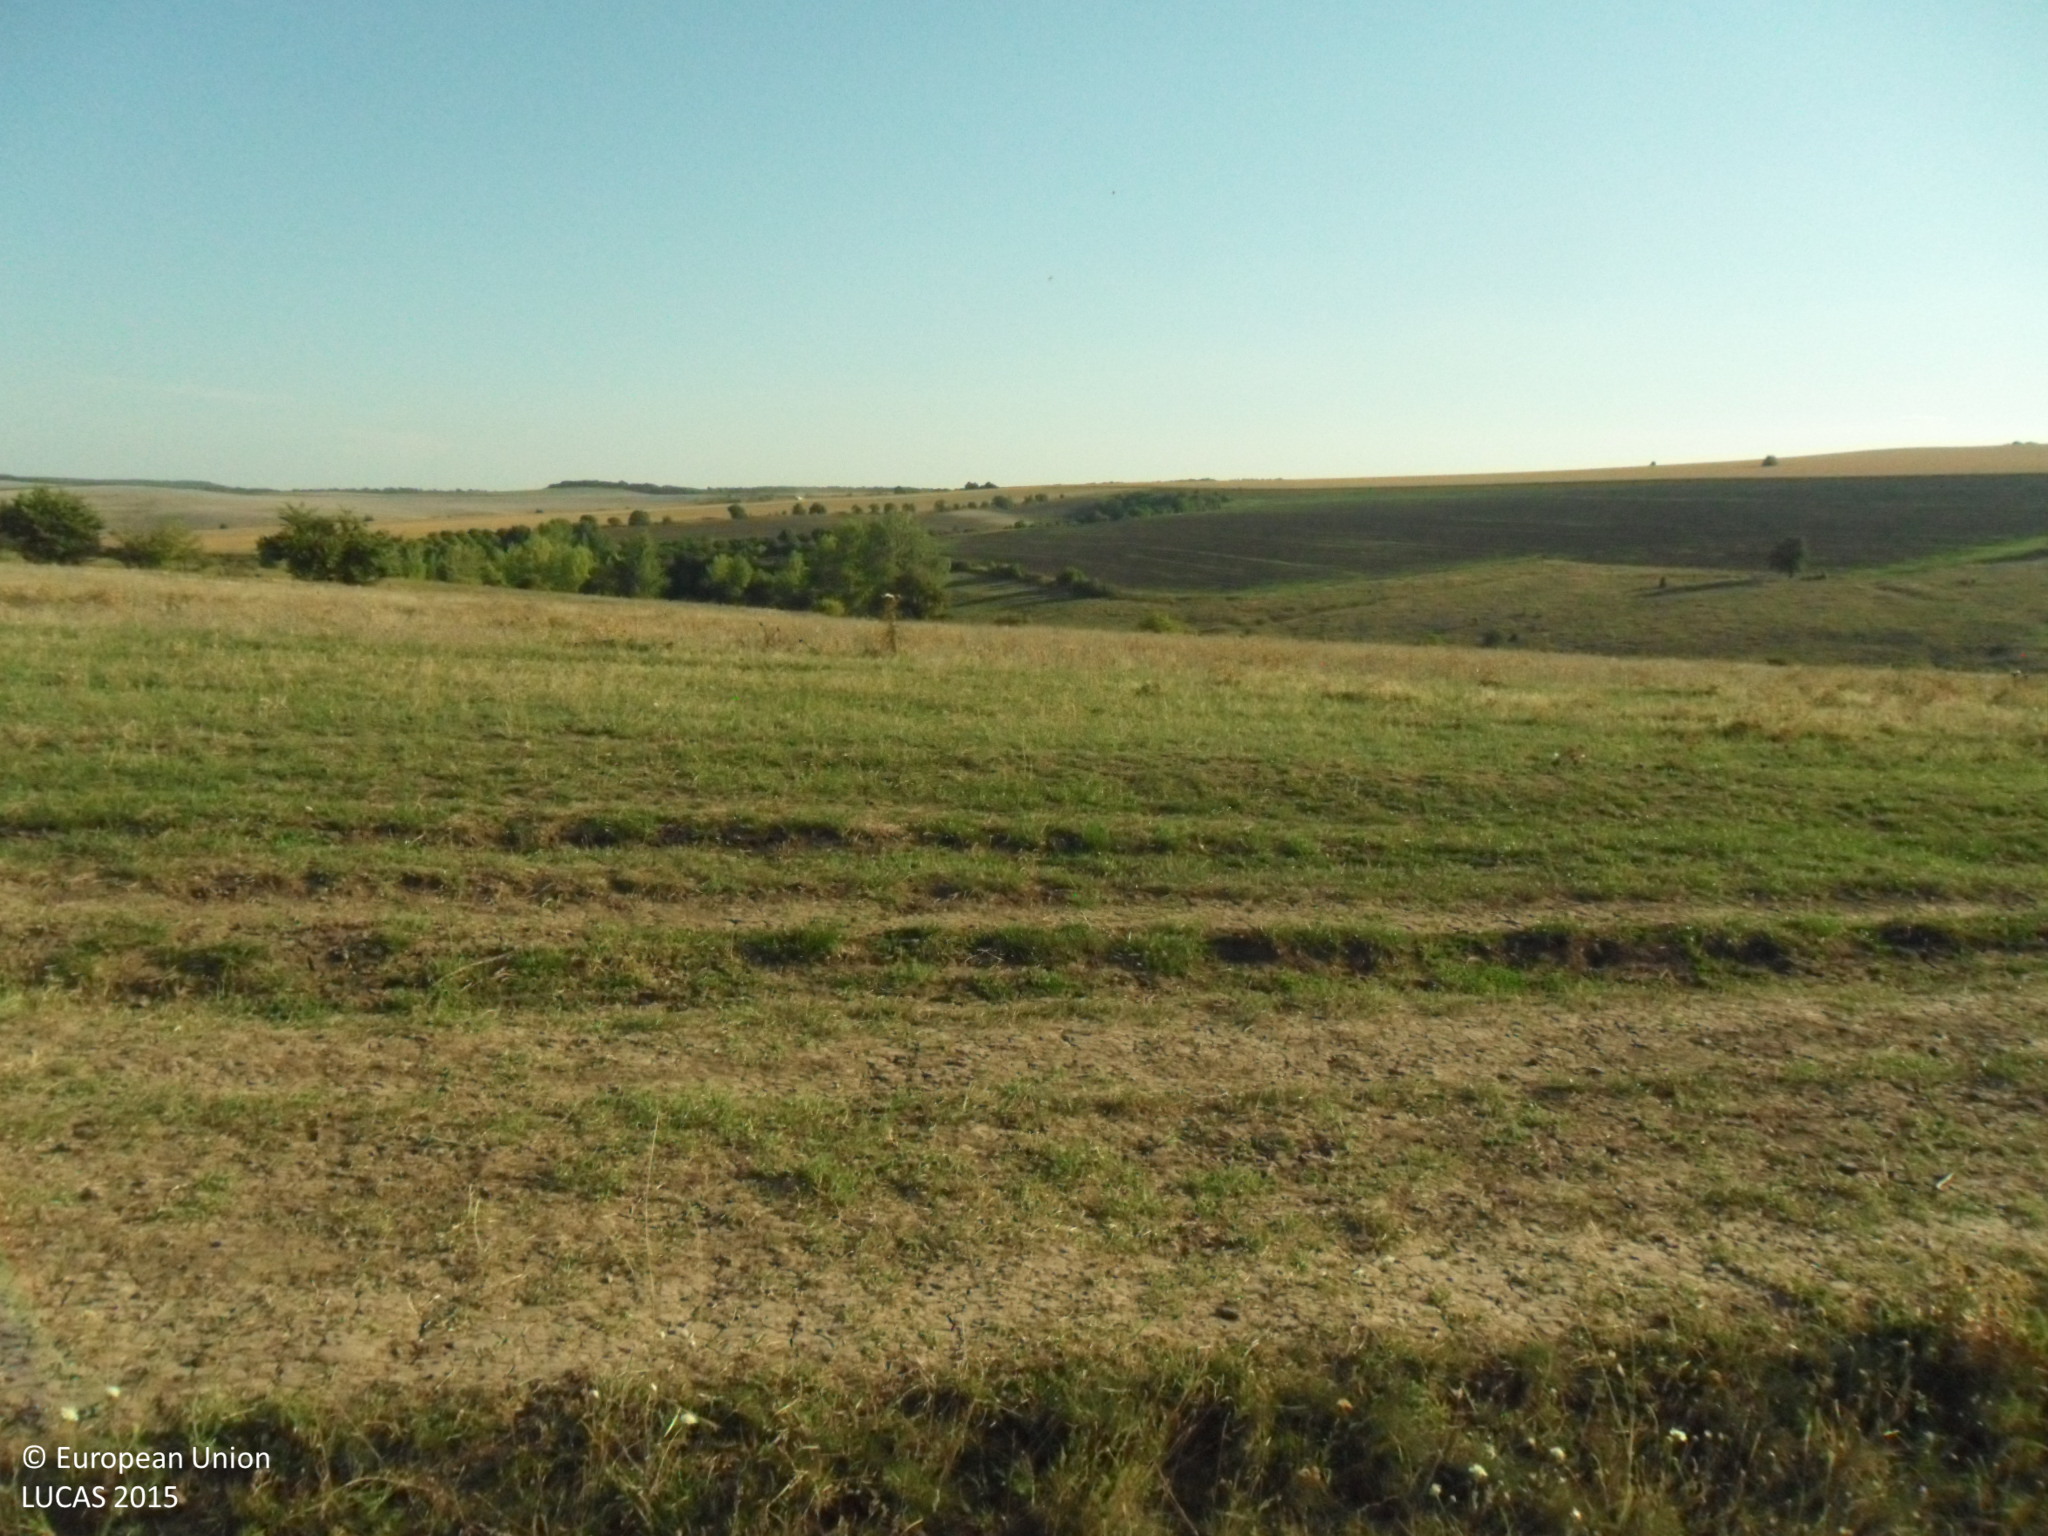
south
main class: Grassland
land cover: Grassland without tree/shrub cover
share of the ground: > 75 %
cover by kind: herbaceous plants 100 %
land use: Agriculture (excluding fallow land and kitchen gardens)
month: September
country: BG
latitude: 43.4513
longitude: 27.2130
